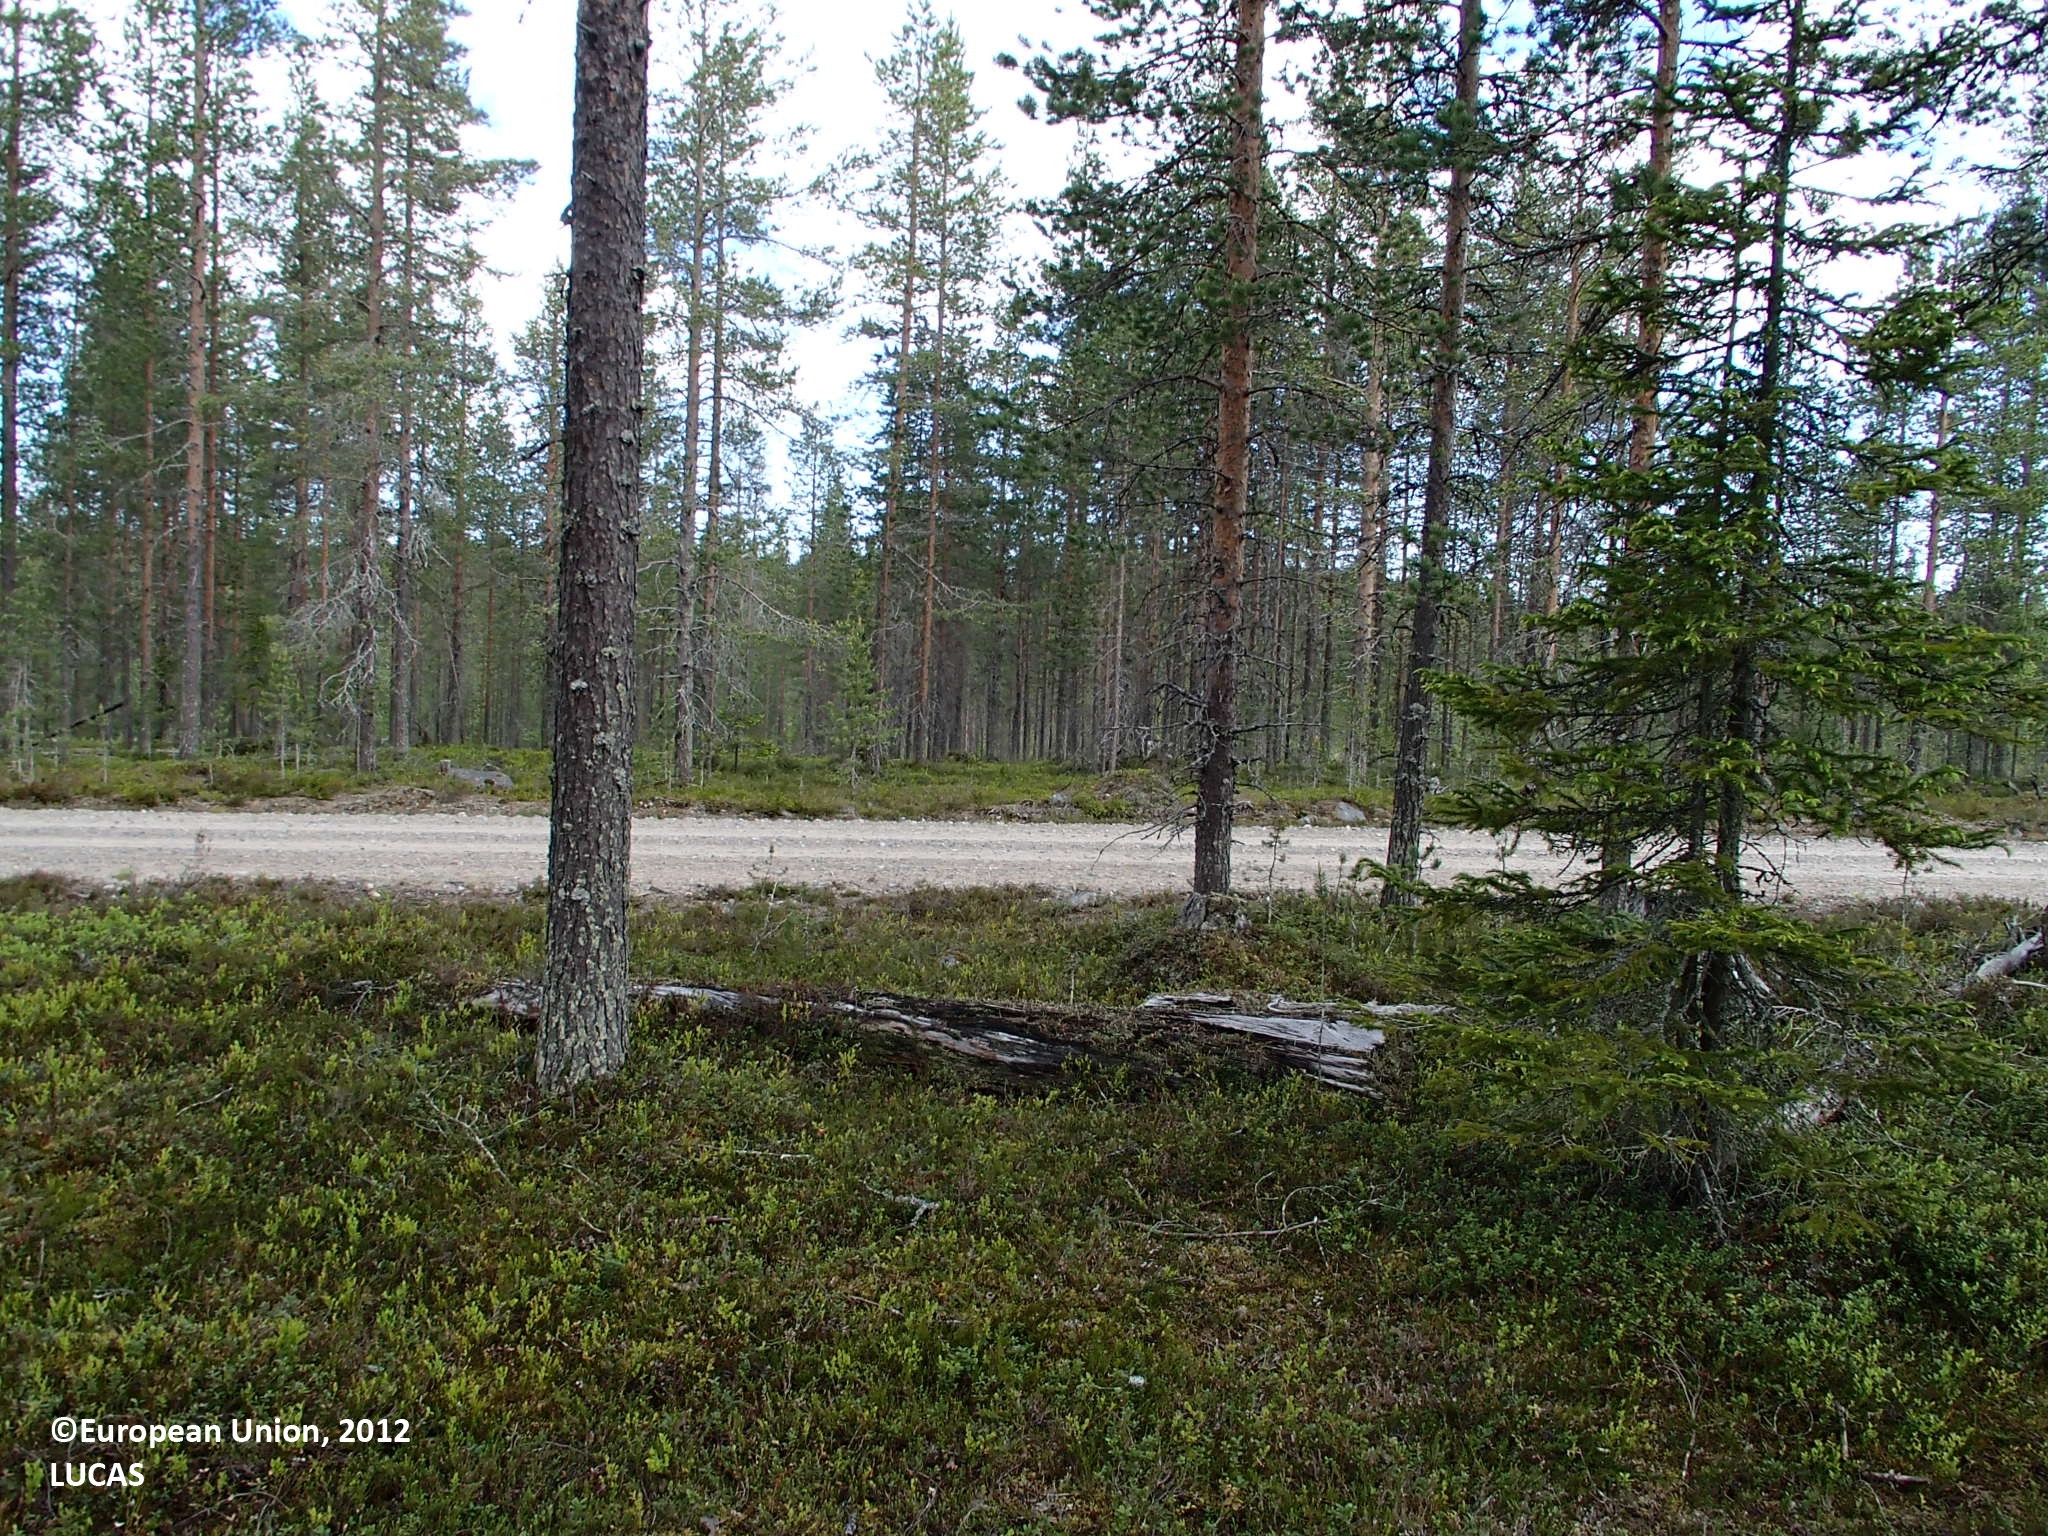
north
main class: Woodland
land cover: Pine dominated coniferous woodland
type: boreal forest
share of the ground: > 75 %
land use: Forestry
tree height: > 5 m
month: June
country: FI
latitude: 66.4565
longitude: 27.0863
